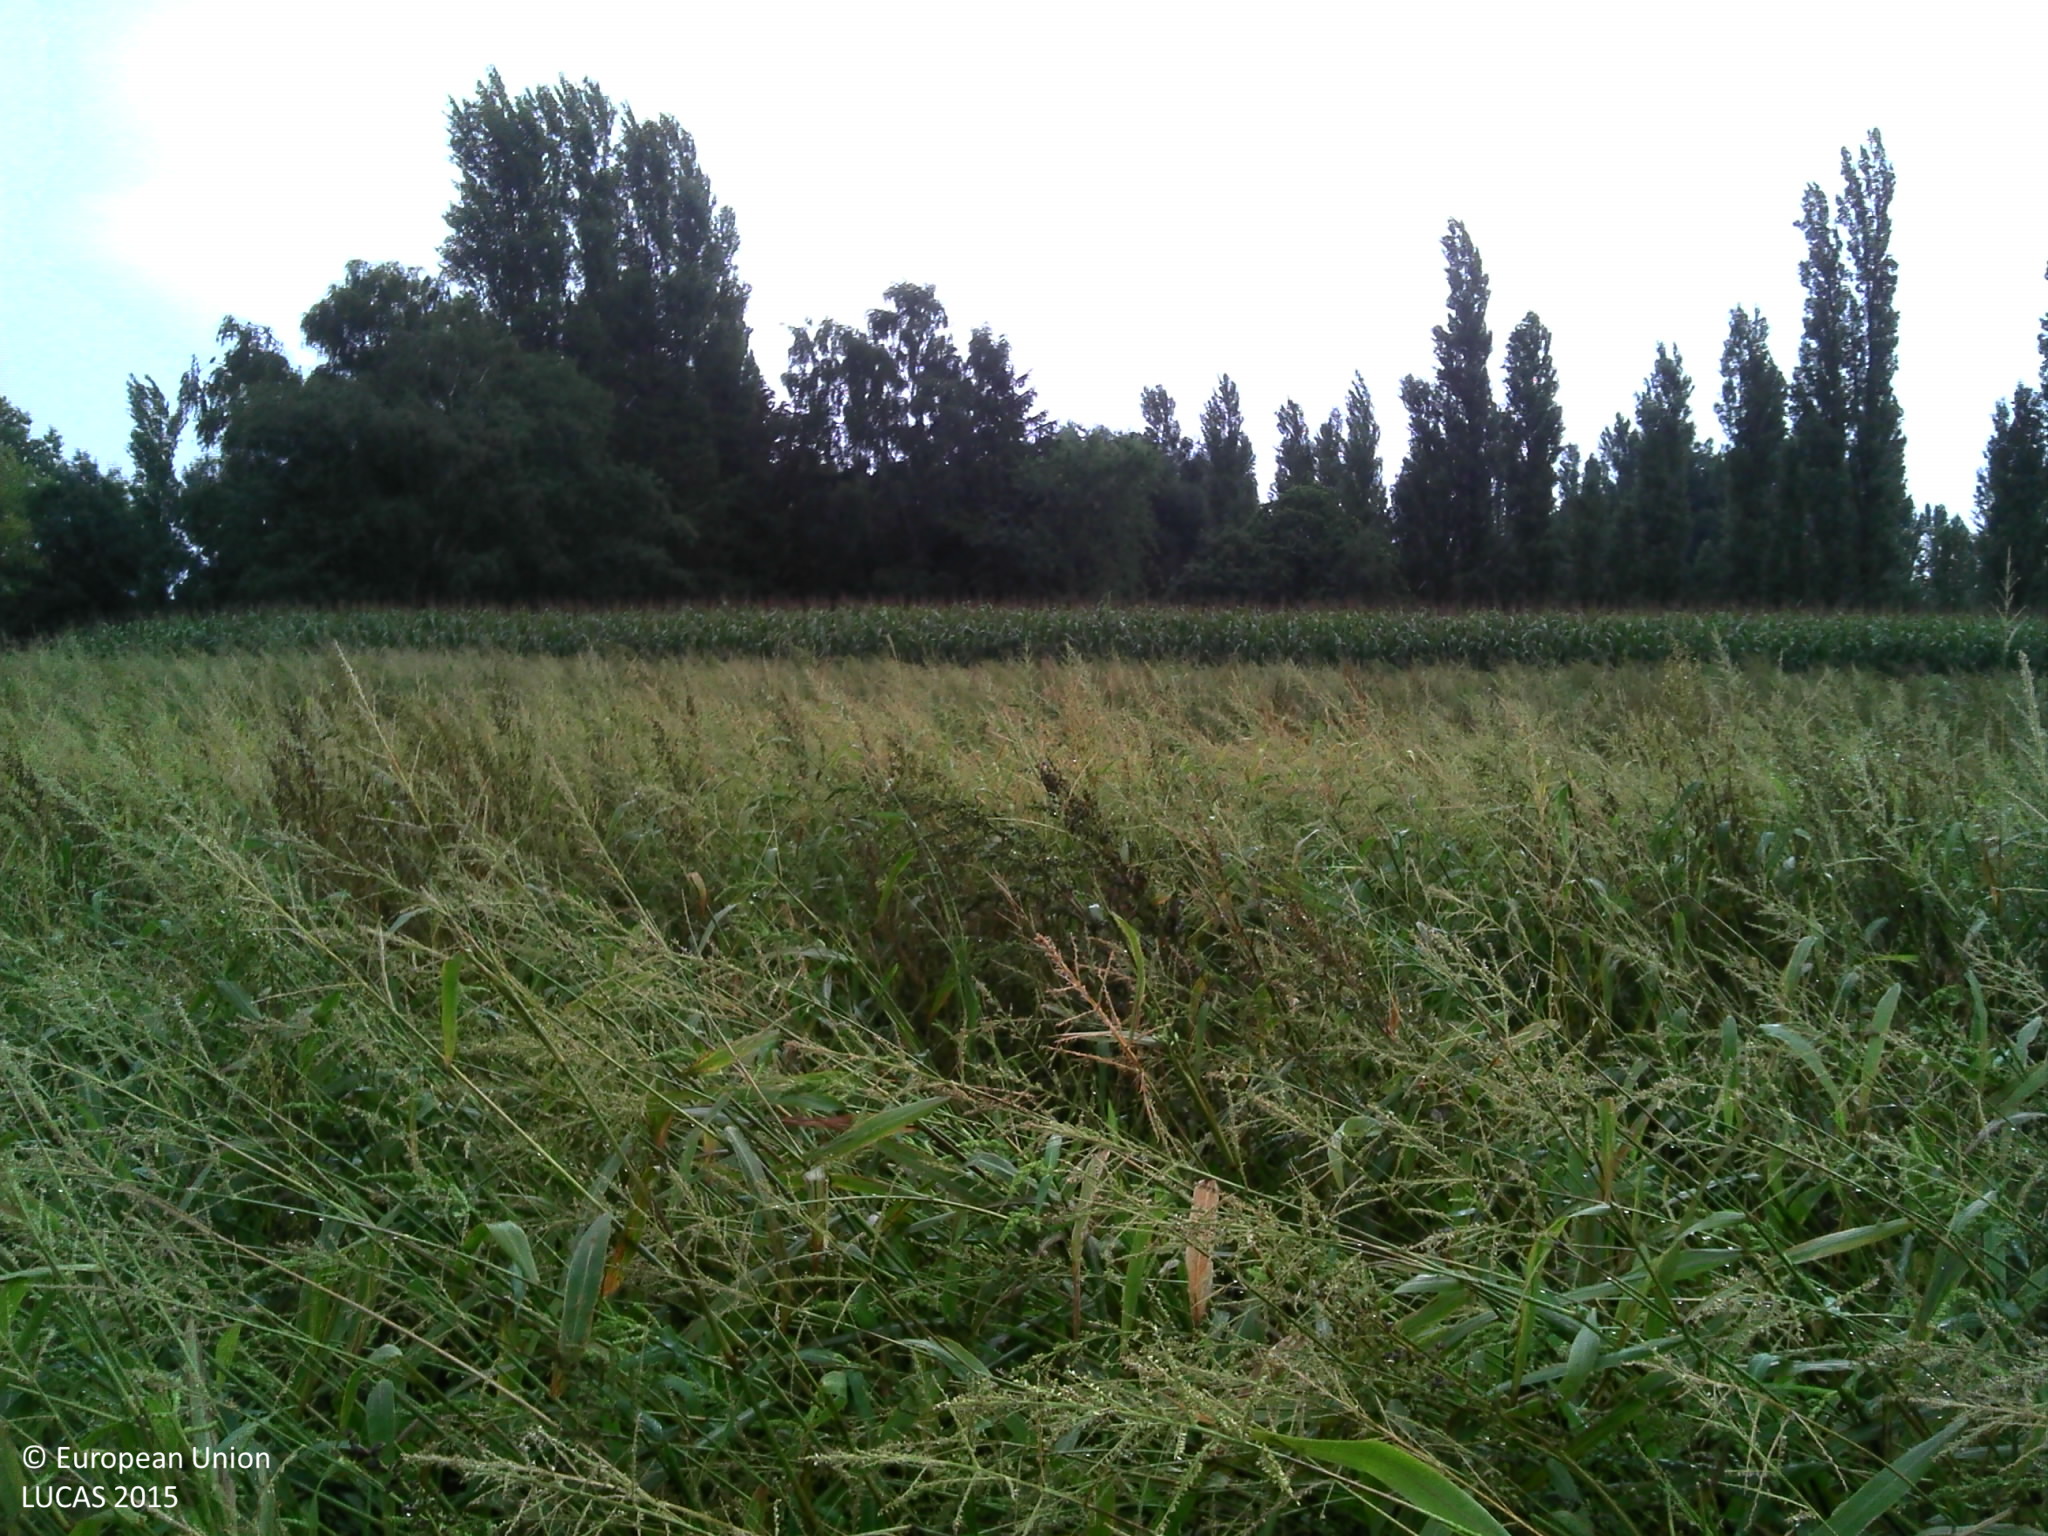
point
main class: Grassland
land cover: Spontaneously vegetated surfaces
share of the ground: > 75 %
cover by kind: herbaceous plants 100 %
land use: Fallow land
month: September
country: BE
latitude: 51.1797
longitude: 3.0234
